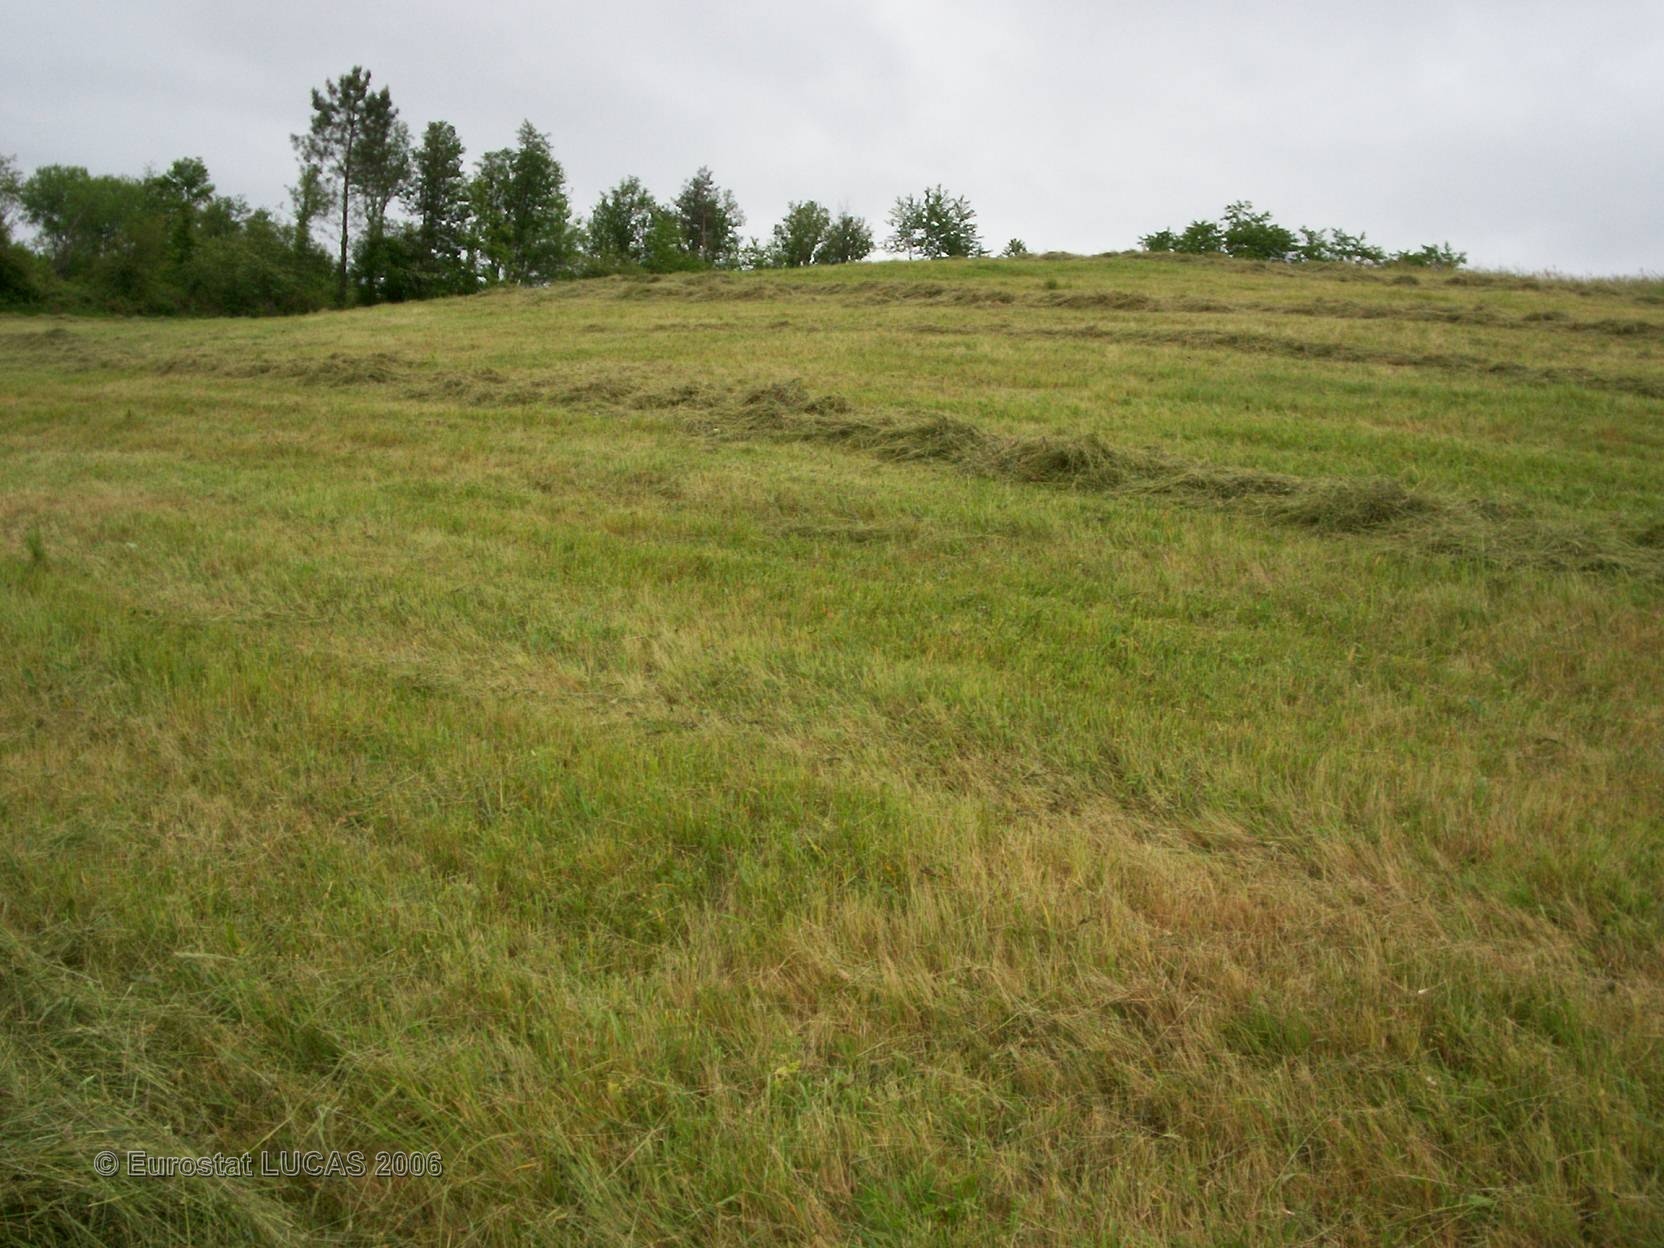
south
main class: Grassland
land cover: Grassland without tree/shrub cover
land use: Agriculture (excluding fallow land and kitchen gardens)
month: May
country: FR
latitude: 45.0159
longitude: 1.2769
